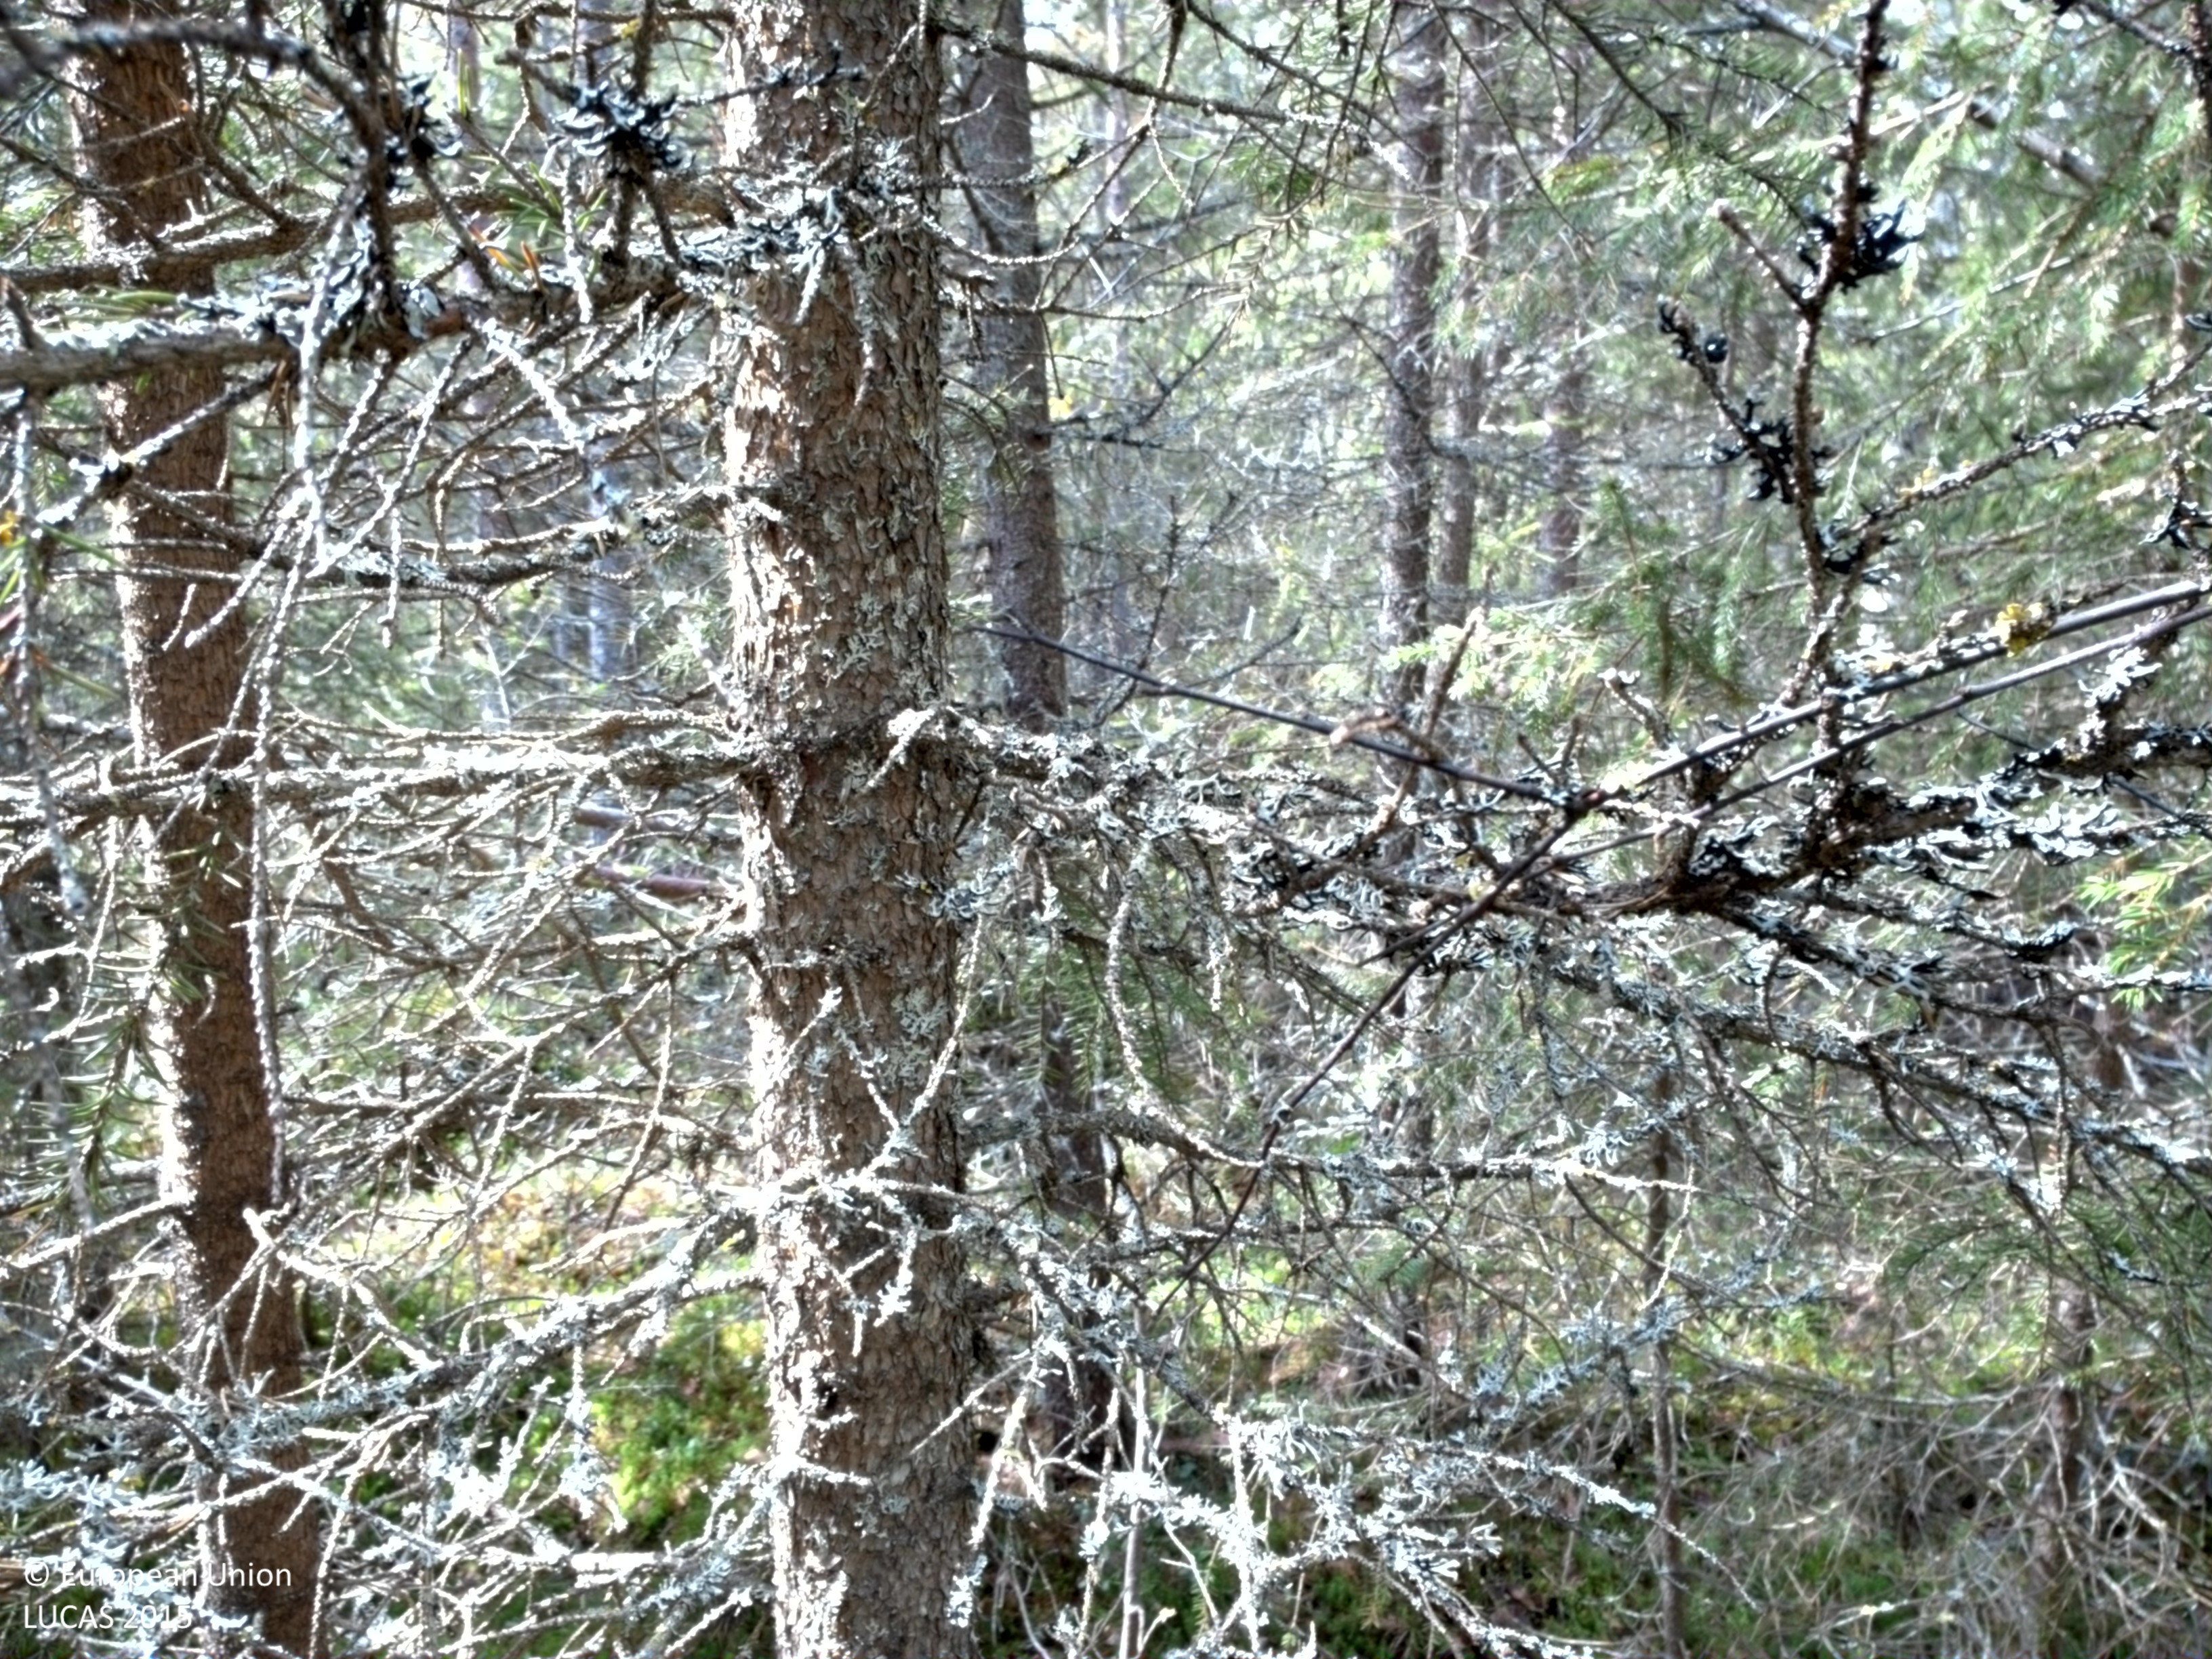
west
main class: Woodland
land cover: Other mixed woodland
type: boreal forest
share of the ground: > 75 %
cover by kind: coniferous forest trees 60 %, broadleaved forest trees 25 %, shrubs 10 %, lichens and mosses 5 %
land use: Forestry
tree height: > 5 m
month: June
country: SE
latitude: 65.9817
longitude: 23.1306
